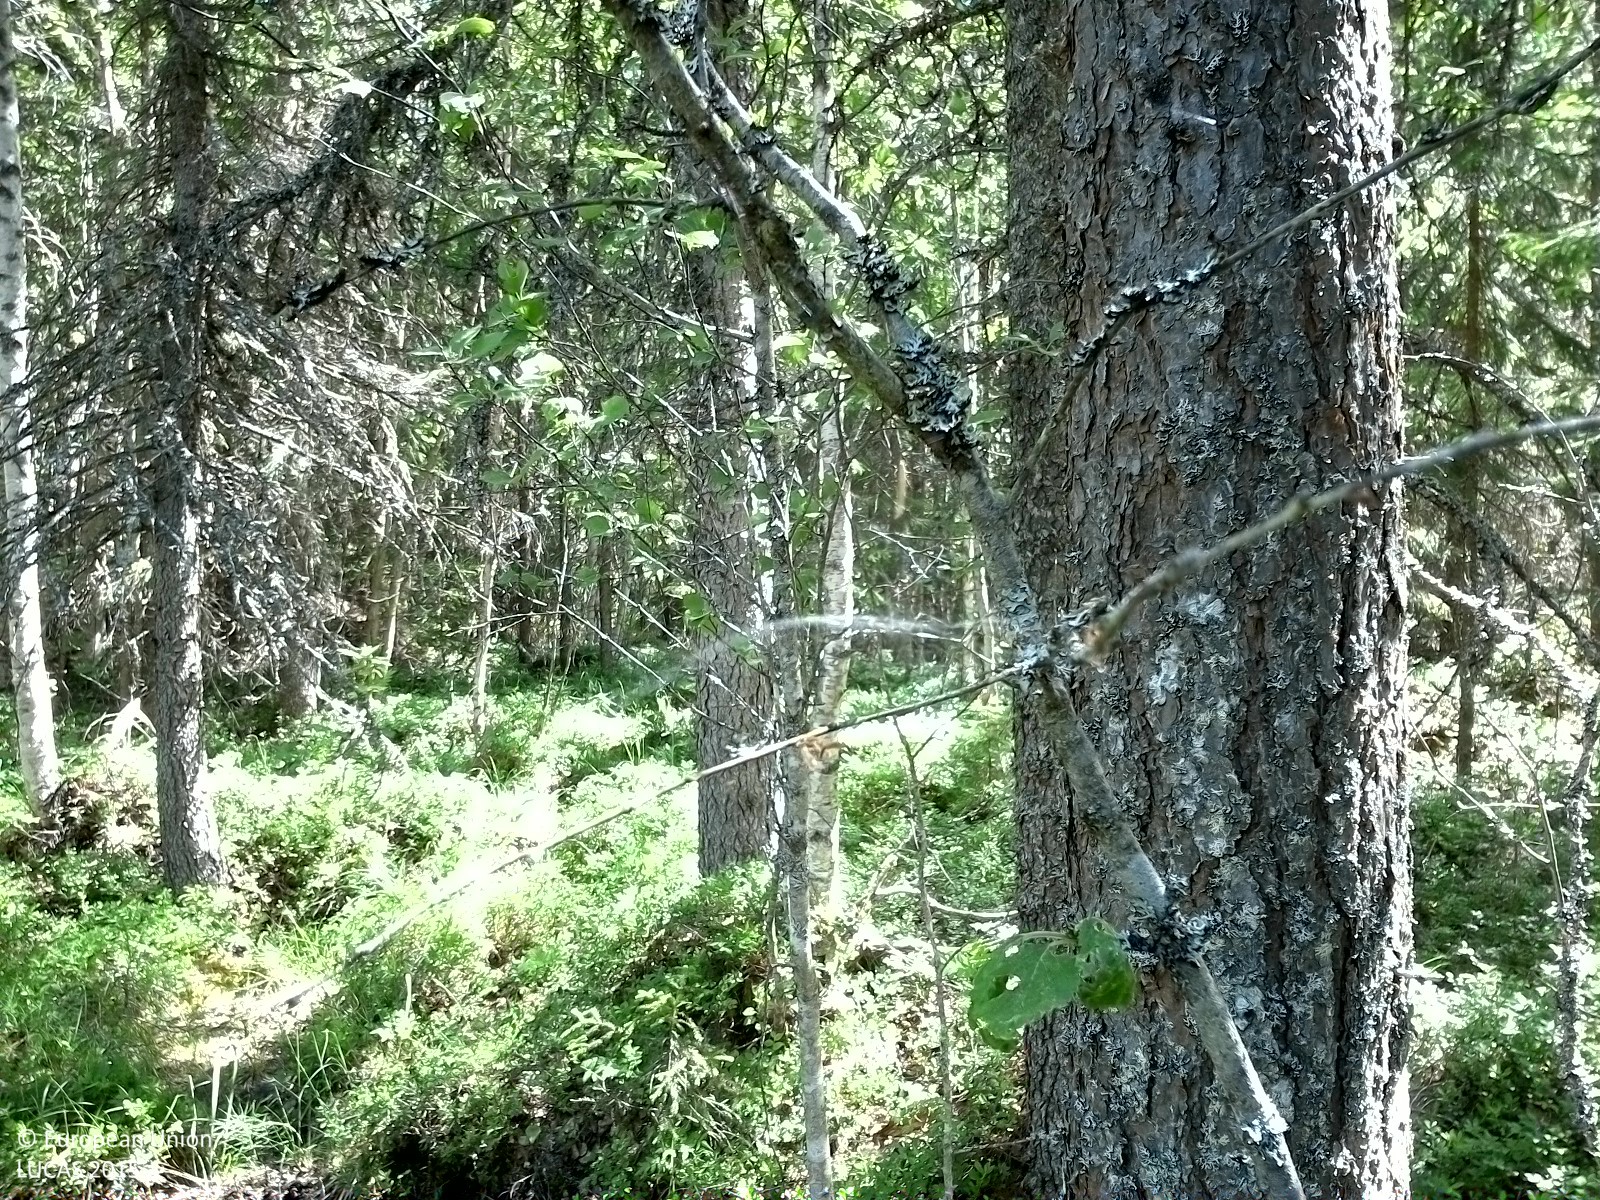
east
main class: Woodland
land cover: Spruce dominated mixed woodland
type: boreal forest
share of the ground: 50 - 75 %
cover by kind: coniferous forest trees 45 %, shrubs 30 %, broadleaved forest trees 15 %, herbaceous plants 10 %
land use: Forestry
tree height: > 5 m
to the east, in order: Spruce dominated mixed woodland; Rocks and stones; Ditches and canals; Paved roads, cycling and walking lanes; Ditches and canals; Pine dominated coniferous woodland; Spruce dominated mixed woodland; Pine dominated coniferous woodland
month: July
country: SE
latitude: 62.2535
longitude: 16.9314
